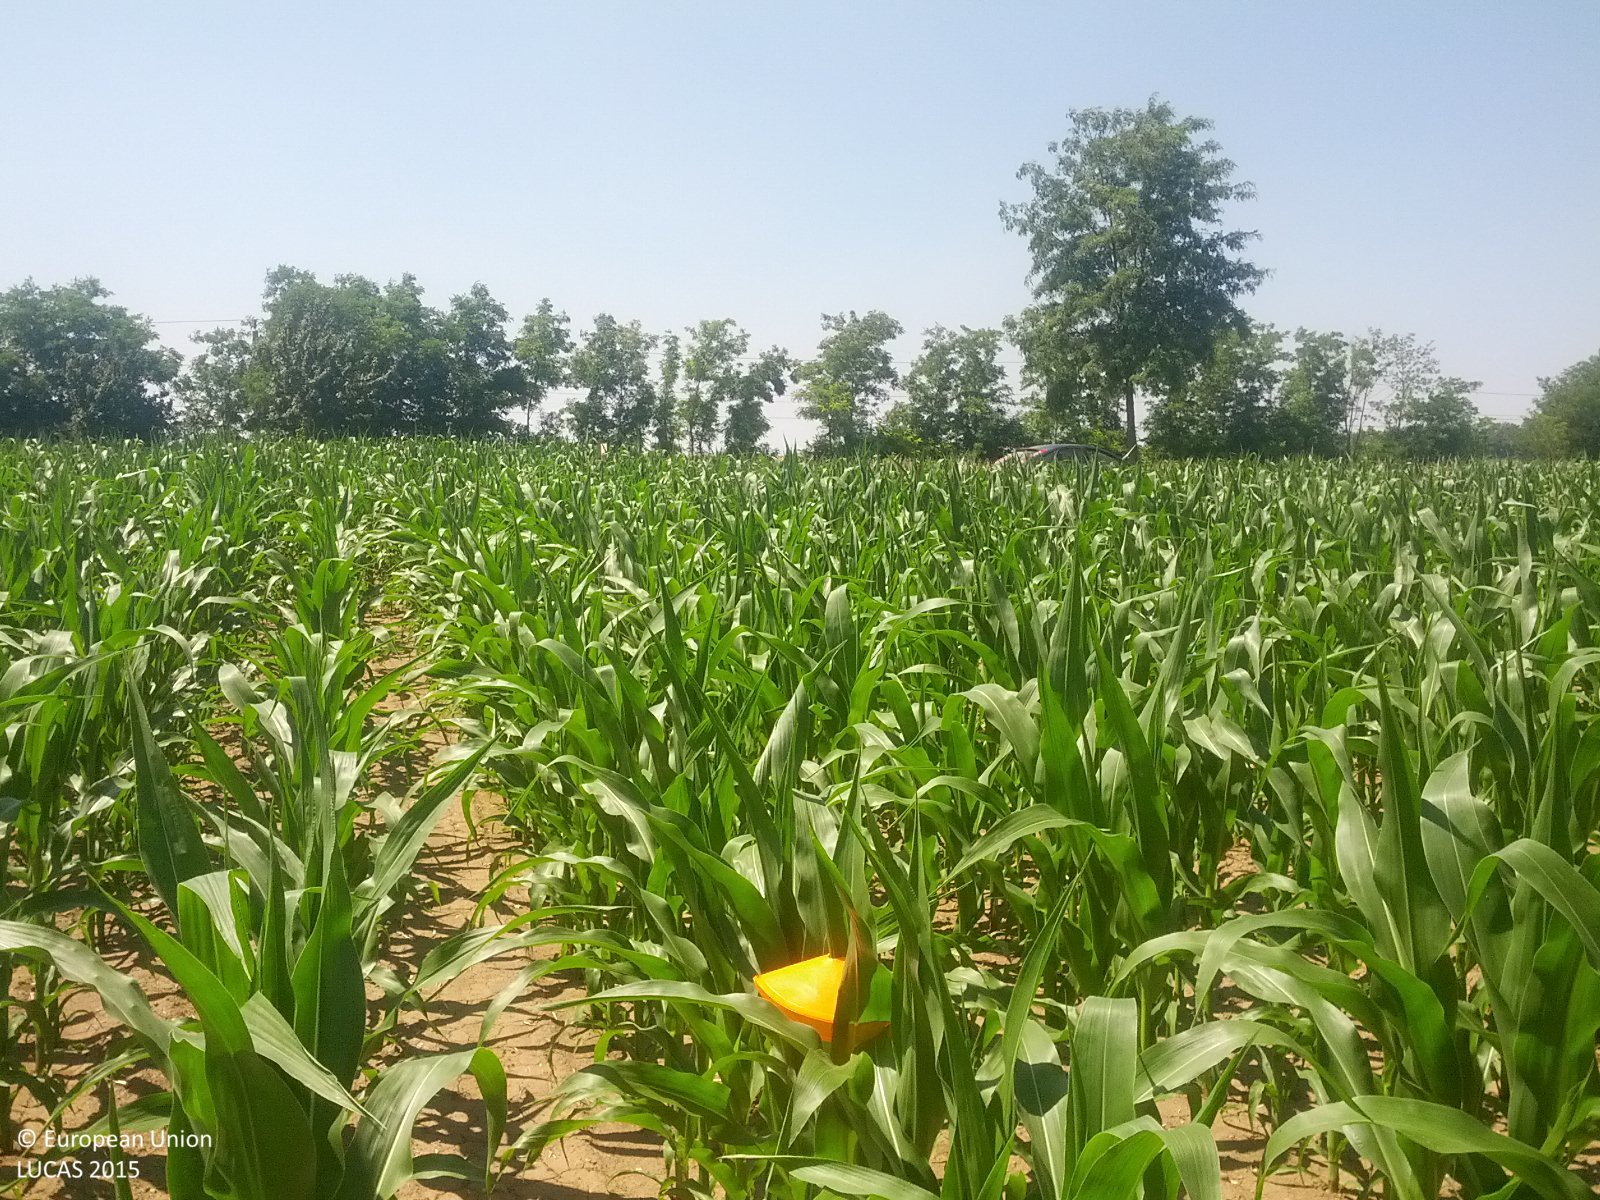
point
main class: Cropland
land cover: Maize
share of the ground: > 75 %
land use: Agriculture (excluding fallow land and kitchen gardens)
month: July
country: AT
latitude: 48.5880
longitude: 16.5545
